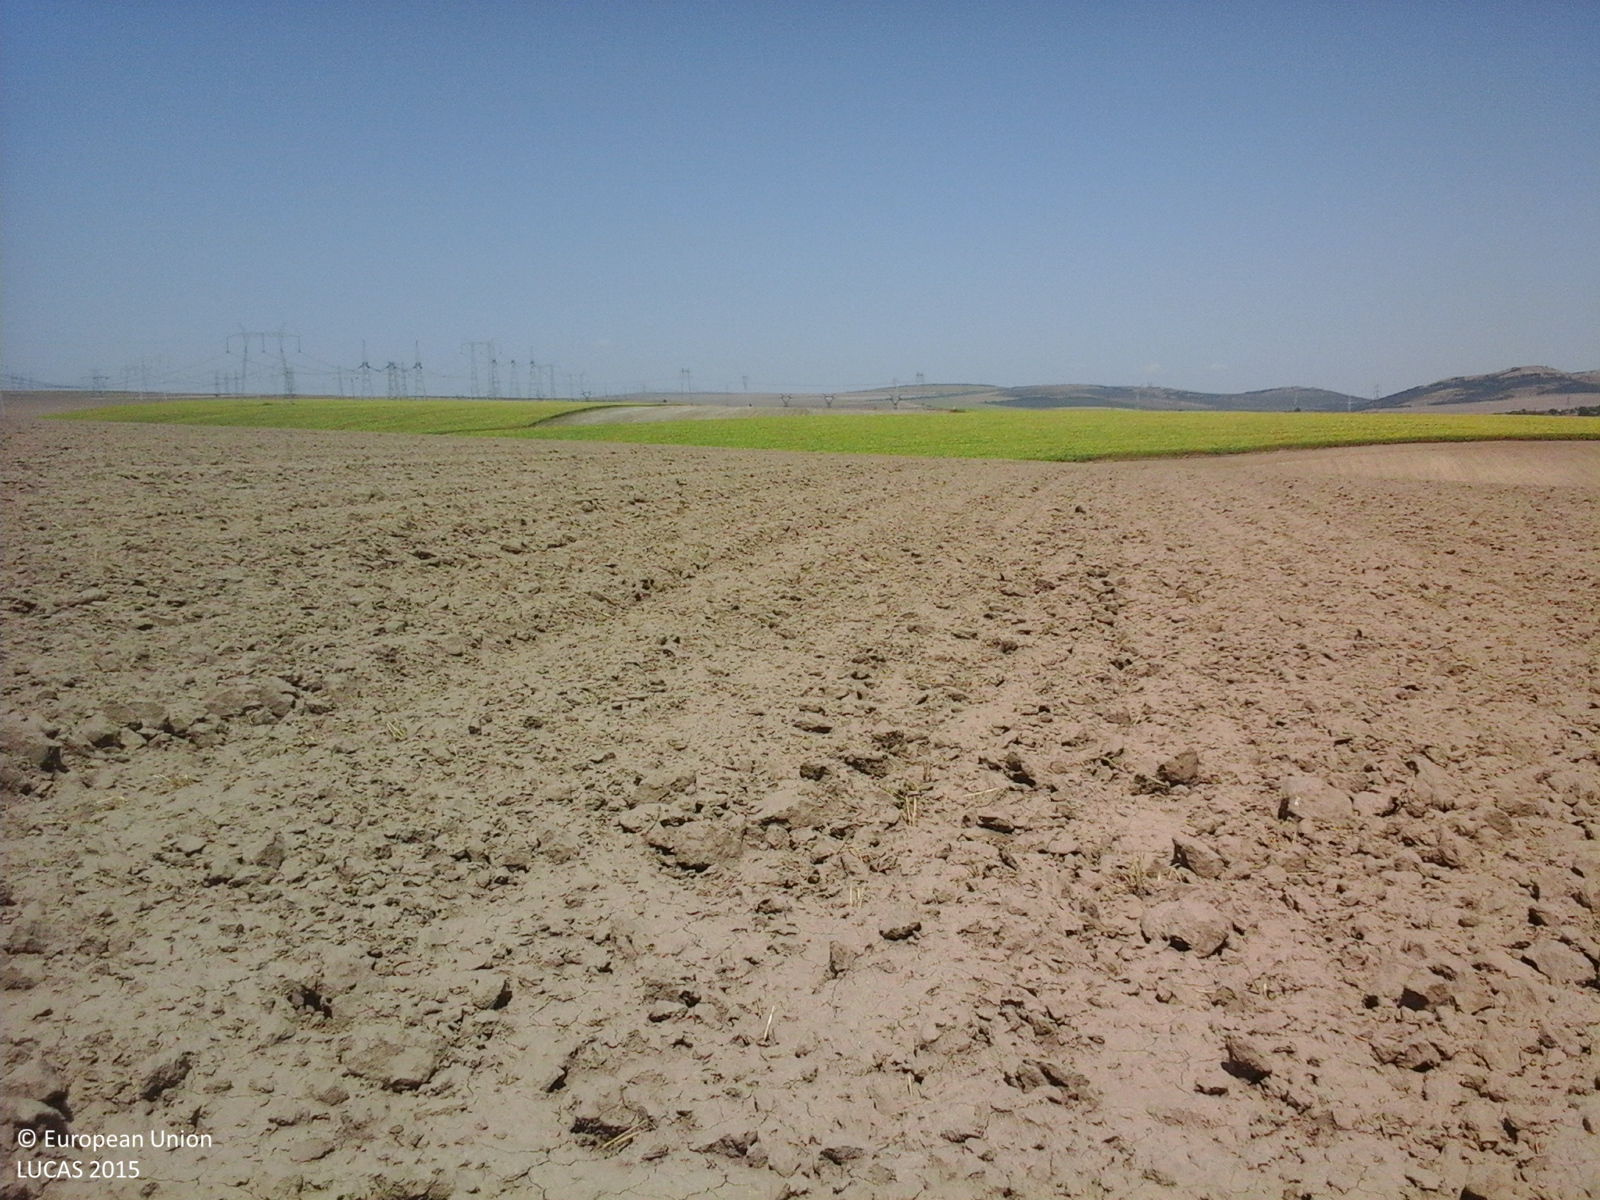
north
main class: Cropland
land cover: Common wheat
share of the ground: < 10 %
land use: Agriculture (excluding fallow land and kitchen gardens)
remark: Harvested field
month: August
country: RO
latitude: 44.4634
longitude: 28.1744
